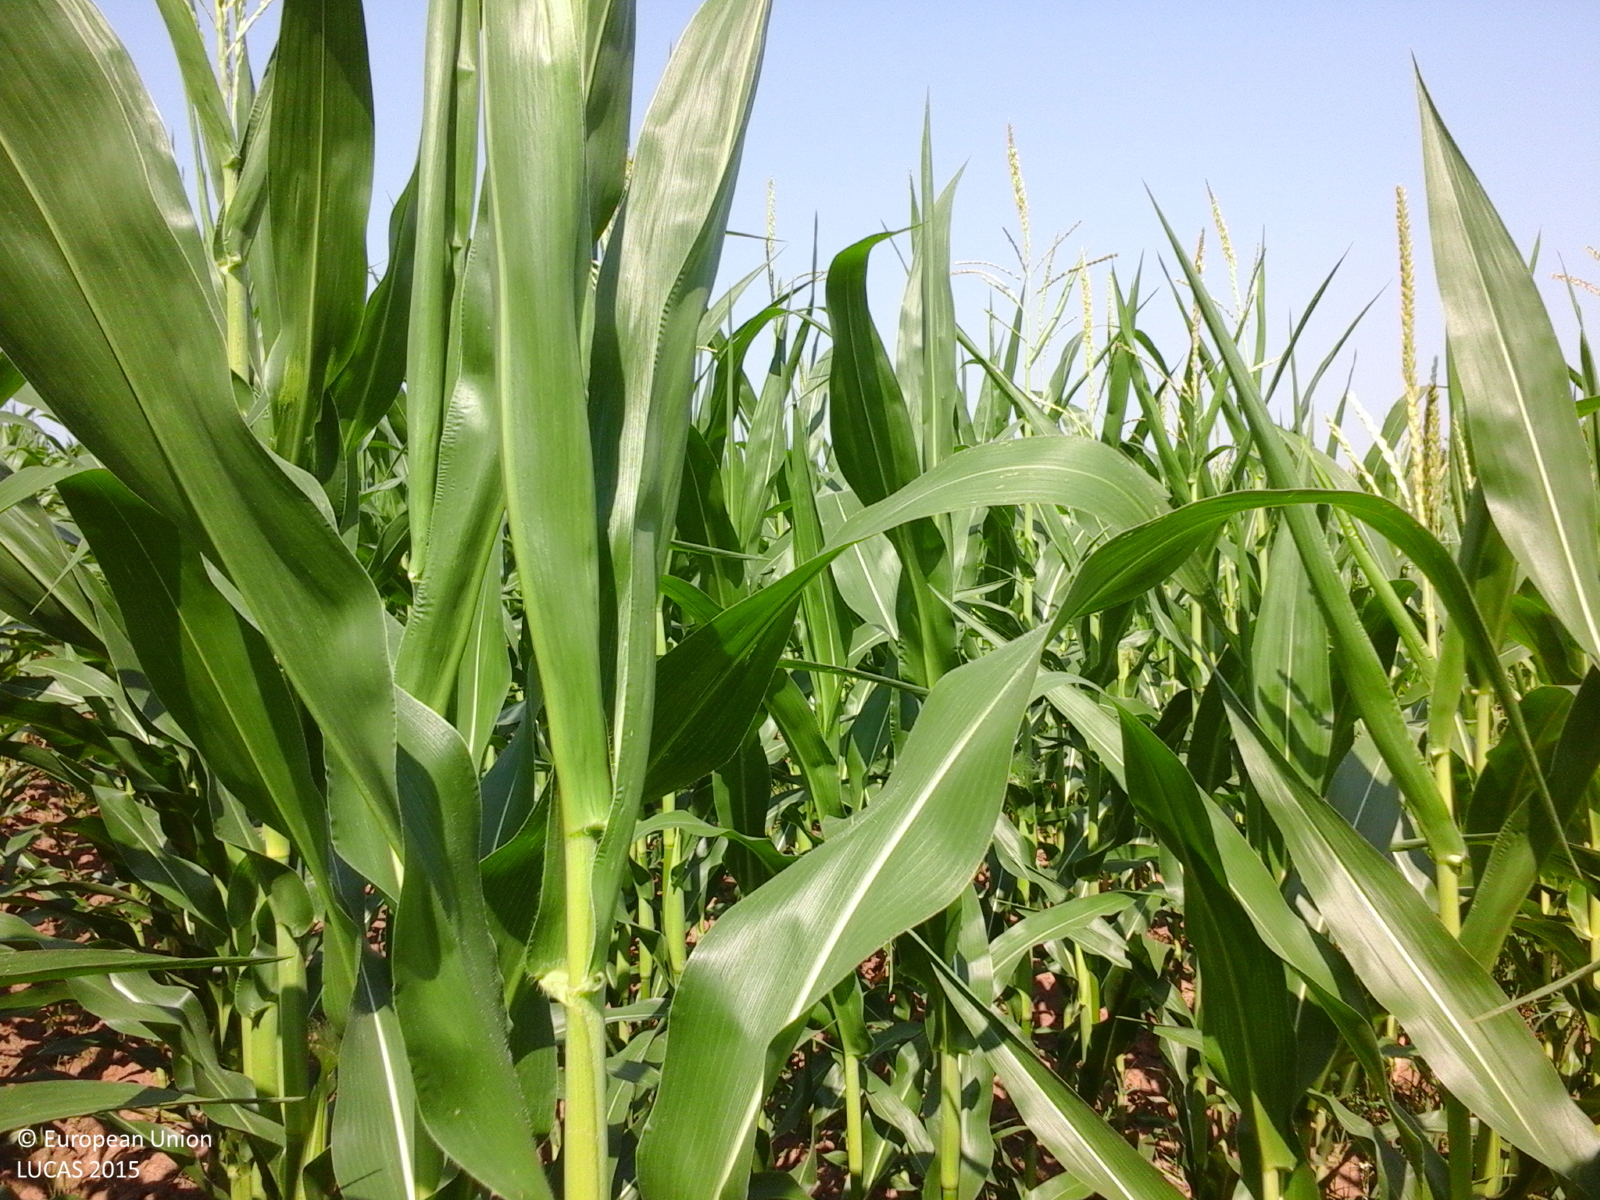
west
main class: Cropland
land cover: Maize
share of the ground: > 75 %
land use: Agriculture (excluding fallow land and kitchen gardens)
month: July
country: RO
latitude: 44.7805
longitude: 25.4481
